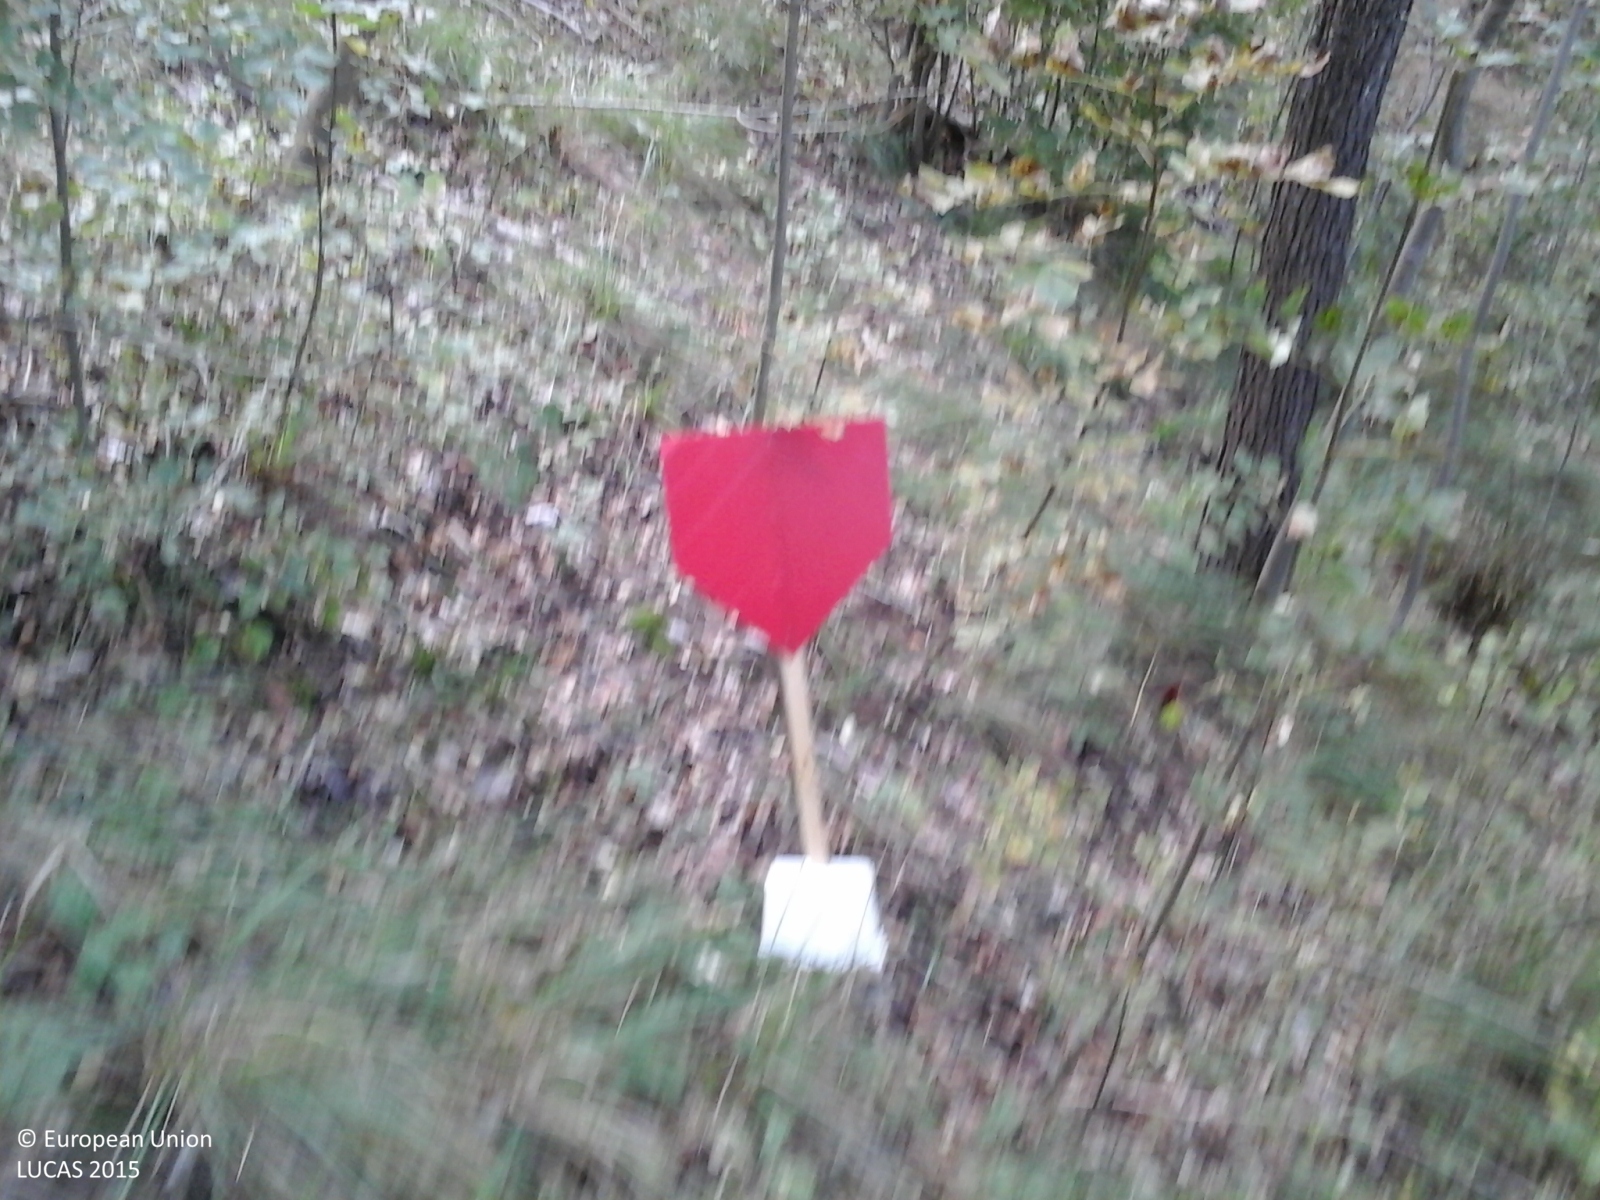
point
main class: Woodland
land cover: Broadleaved woodland
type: thermophilous deciduous forest
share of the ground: > 75 %
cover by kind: broadleaved forest trees 70 %, herbaceous plants 20 %, shrubs 10 %
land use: Forestry
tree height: > 5 m
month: September
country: IT
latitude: 44.4466
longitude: 8.4077
